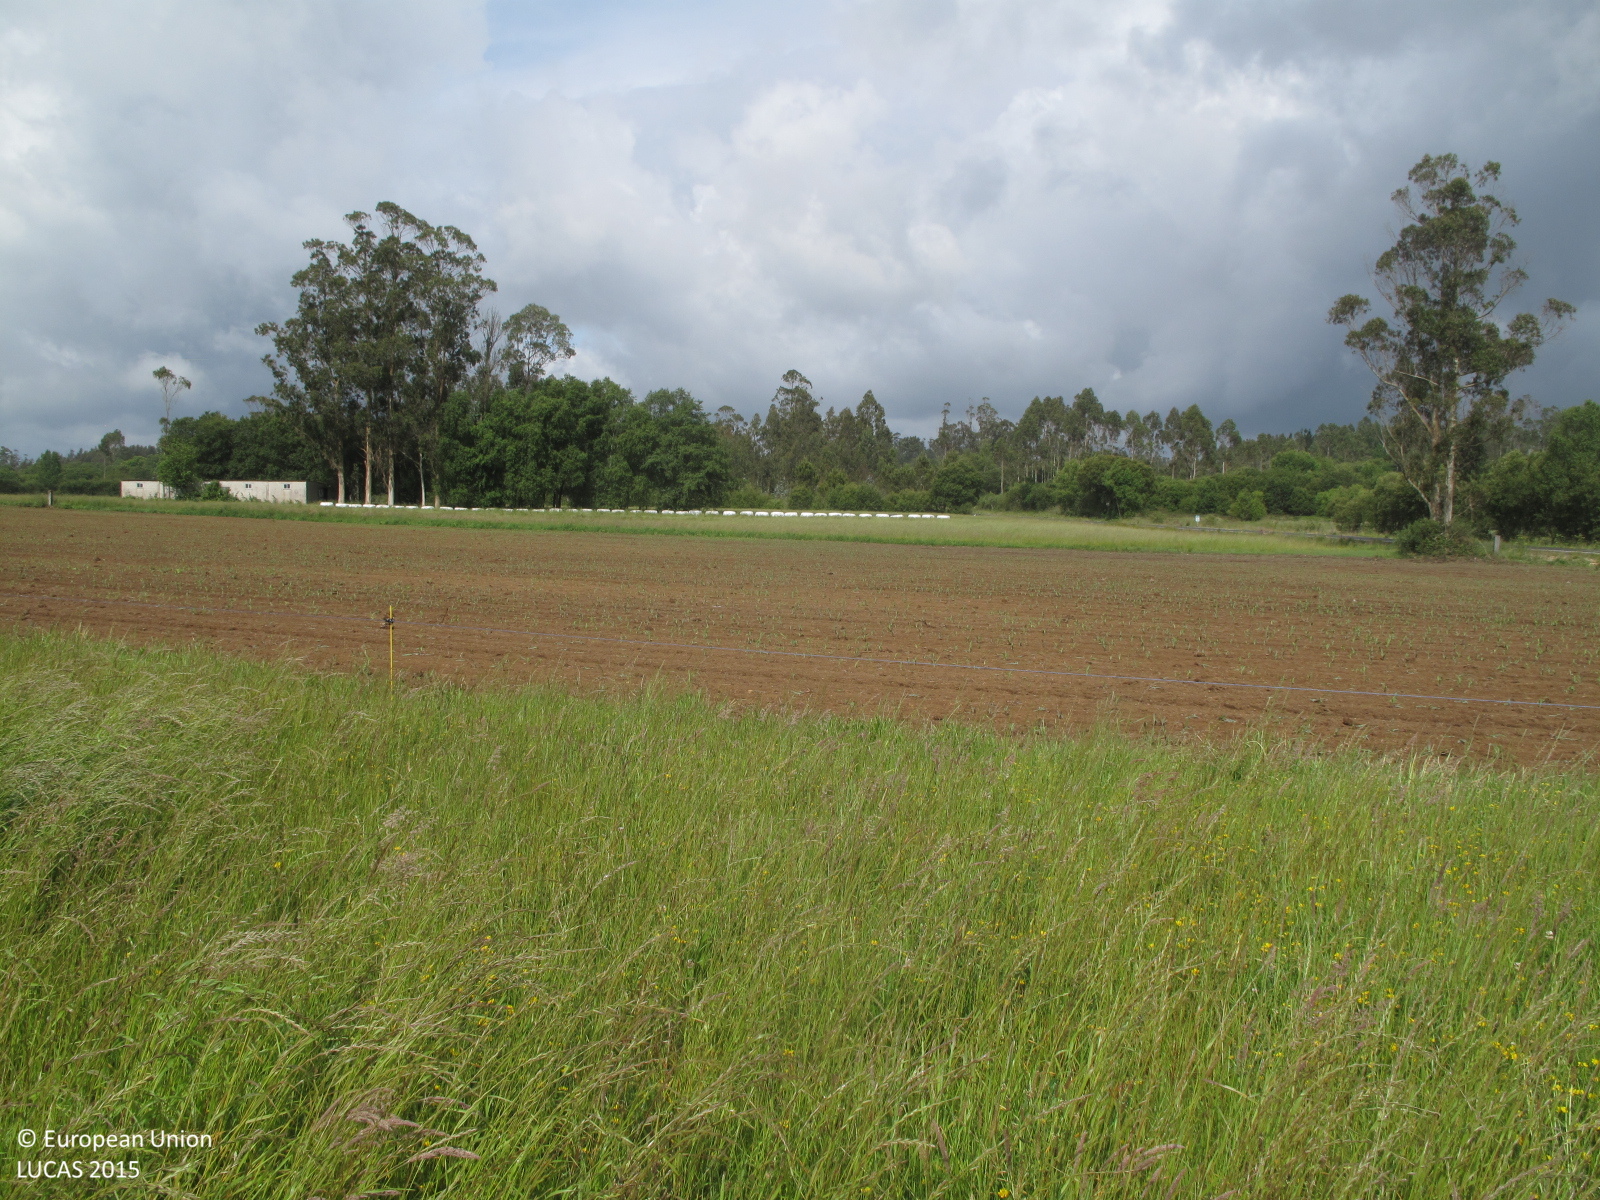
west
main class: Grassland
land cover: Grassland without tree/shrub cover
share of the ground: > 75 %
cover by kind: herbaceous plants 100 %
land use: Agriculture (excluding fallow land and kitchen gardens)
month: June
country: ES
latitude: 43.1289
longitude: -8.6104
